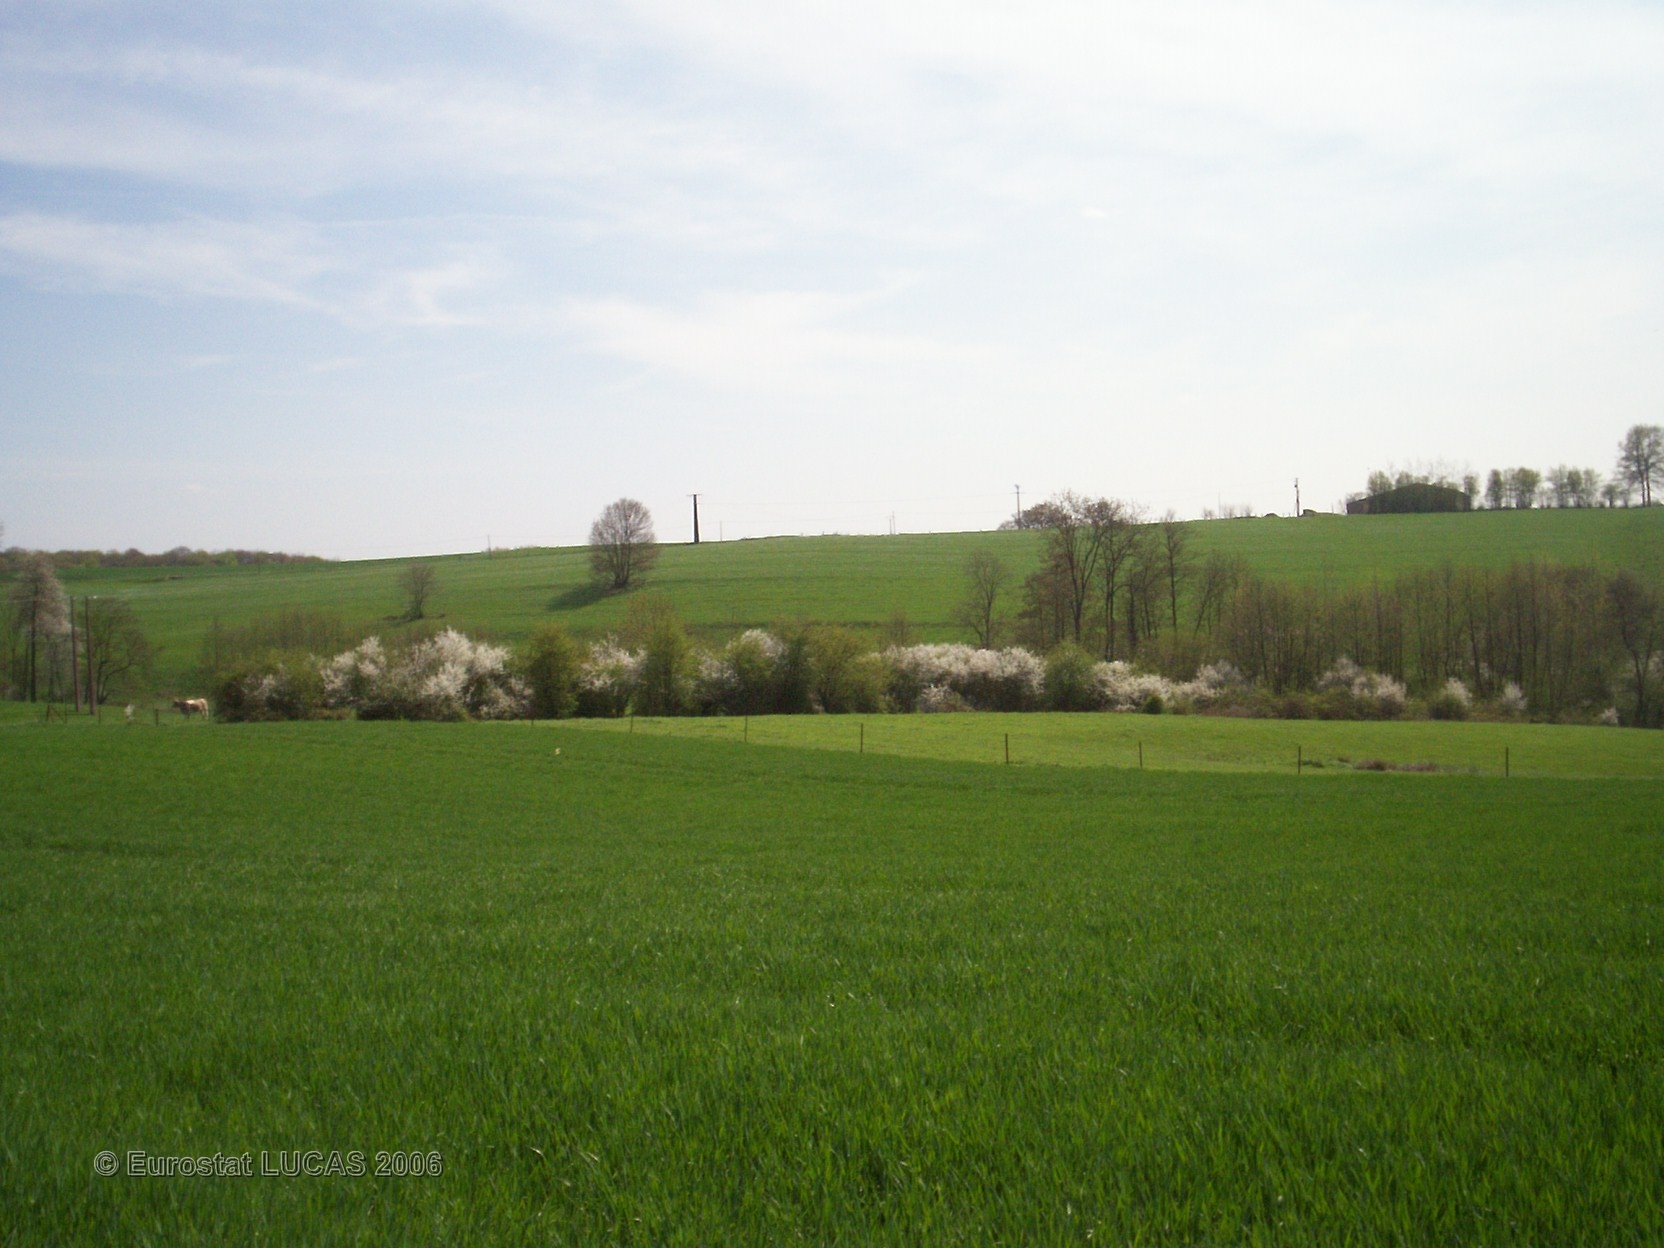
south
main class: Cropland
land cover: Common wheat
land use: Agriculture (excluding fallow land and kitchen gardens)
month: April
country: FR
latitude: 49.7376
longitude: 4.3483
